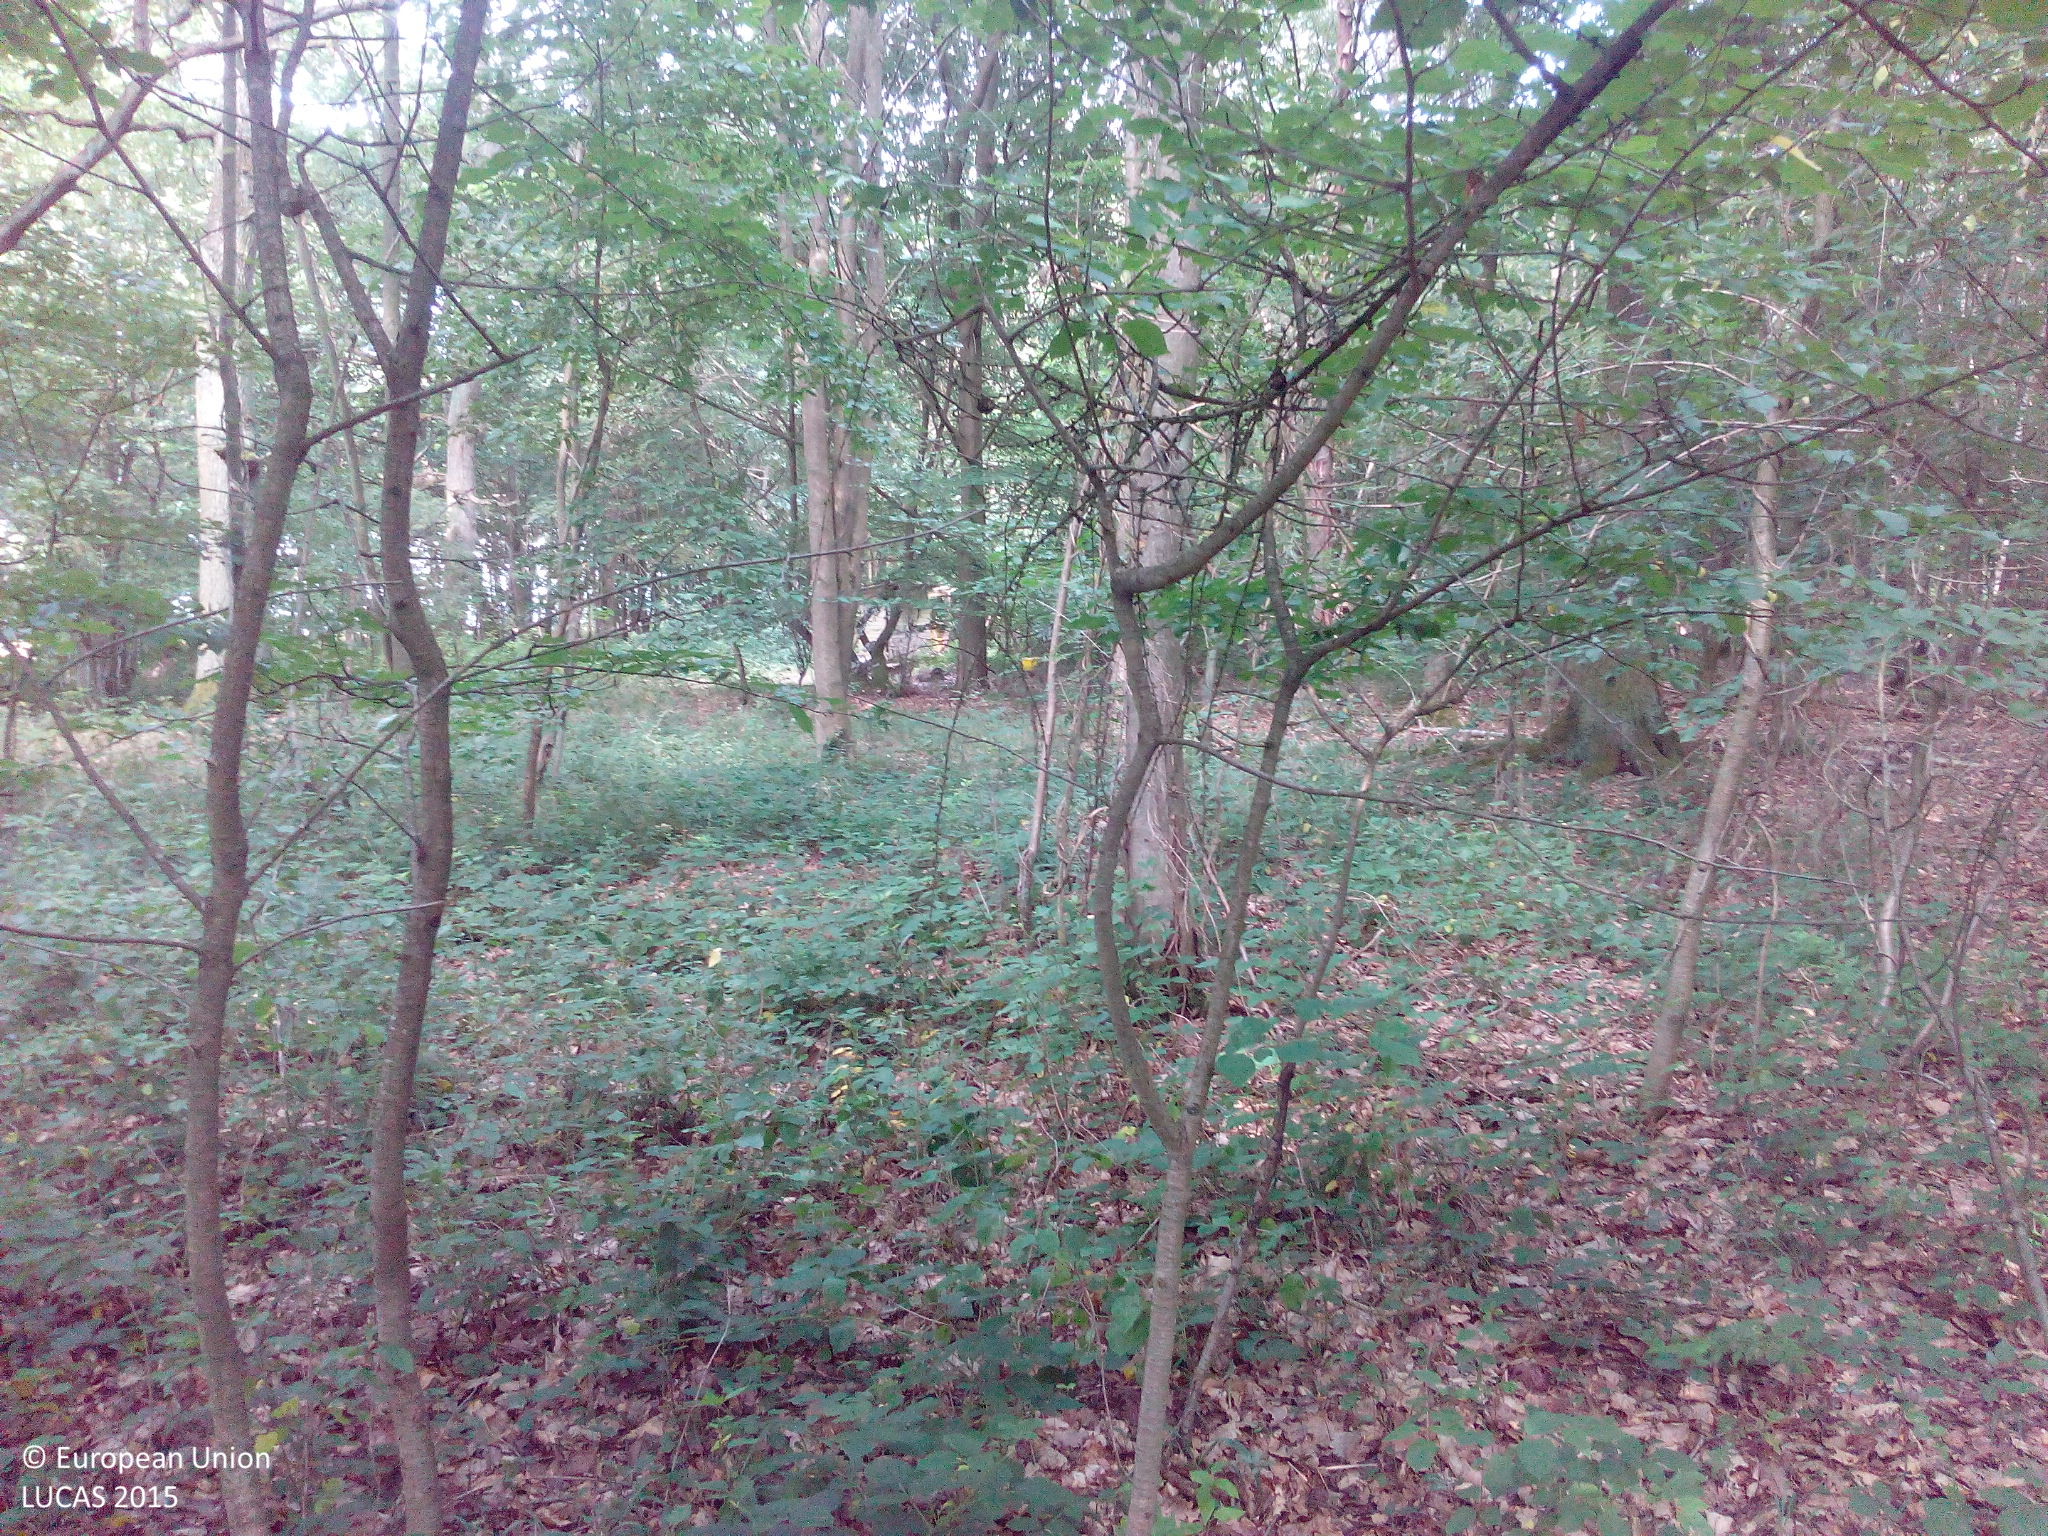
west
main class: Woodland
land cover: Broadleaved woodland
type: beech forest
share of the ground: > 75 %
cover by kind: broadleaved forest trees 75 %, coniferous forest trees 15 %, herbaceous plants 5 %, unconsolidated bare surface 5 %
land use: Forestry
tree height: > 5 m
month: July
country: DE
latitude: 49.8518
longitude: 7.5386
